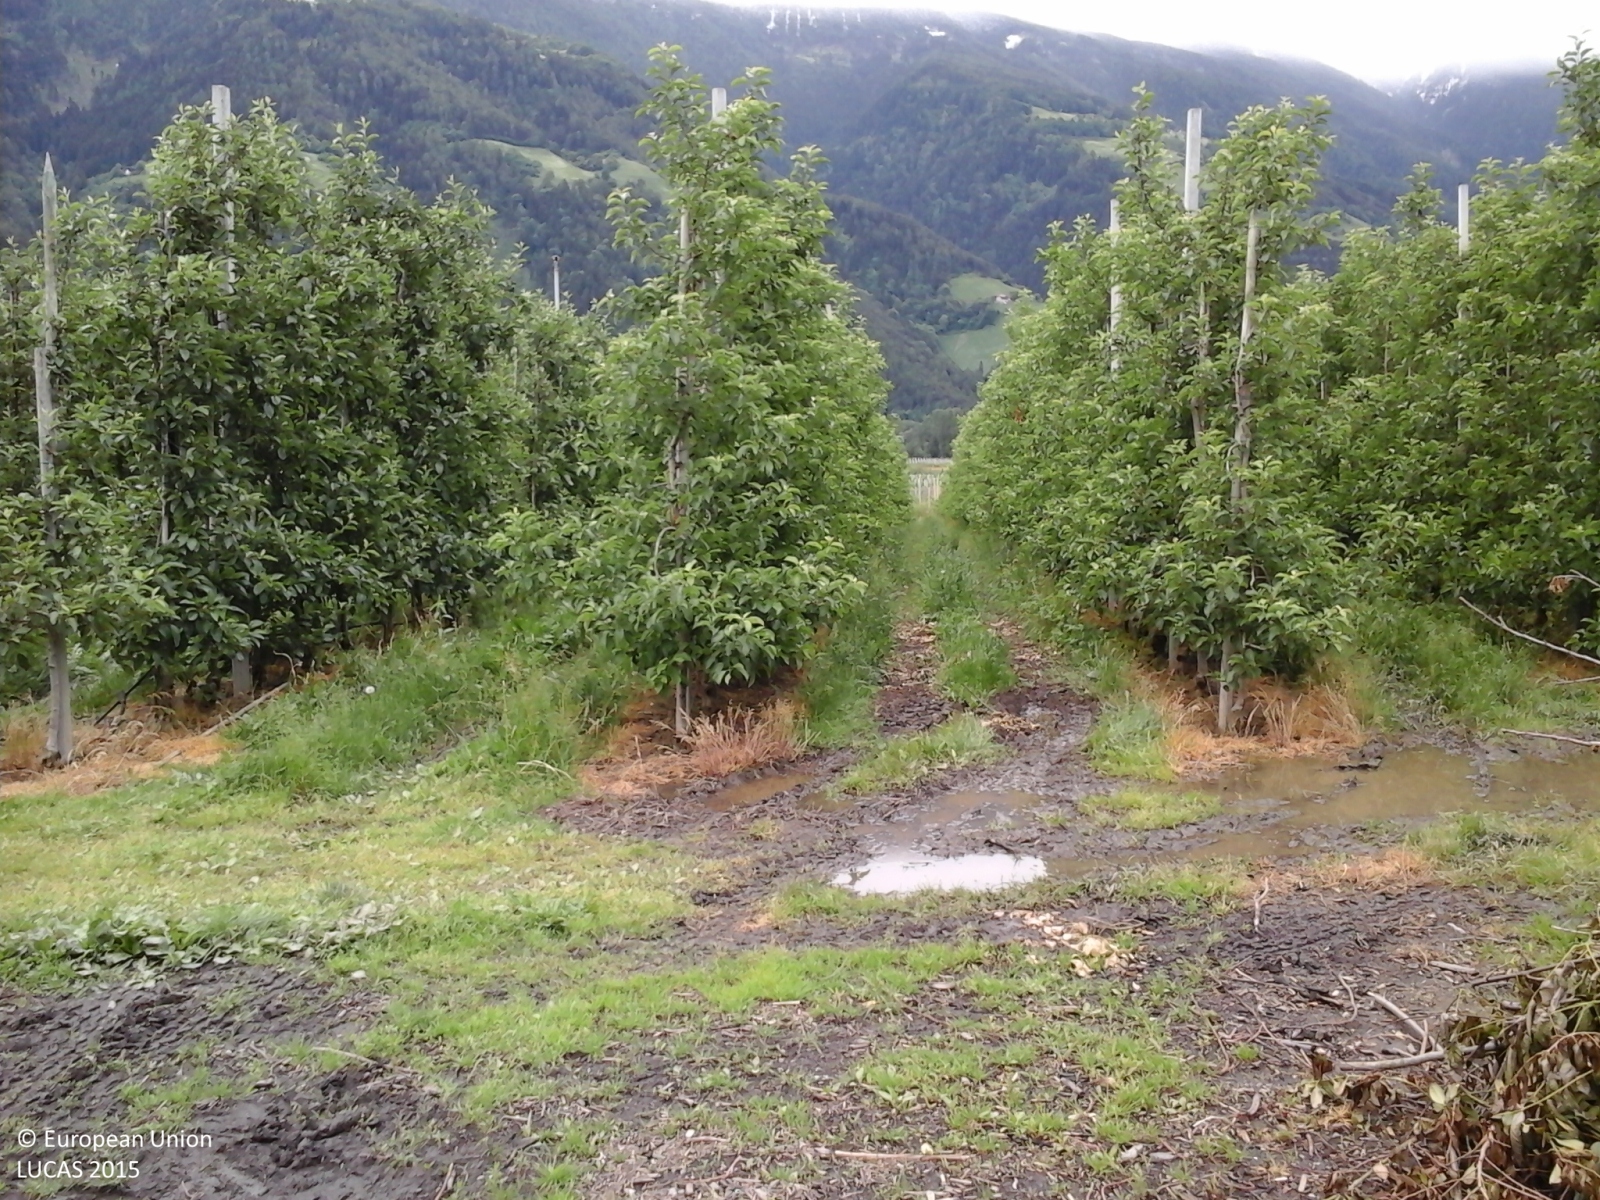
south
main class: Grassland
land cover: Grassland without tree/shrub cover
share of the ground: > 75 %
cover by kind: herbaceous plants 100 %
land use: Agriculture (excluding fallow land and kitchen gardens)
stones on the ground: < 10 %
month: May
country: IT
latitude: 46.6702
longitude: 11.0575
